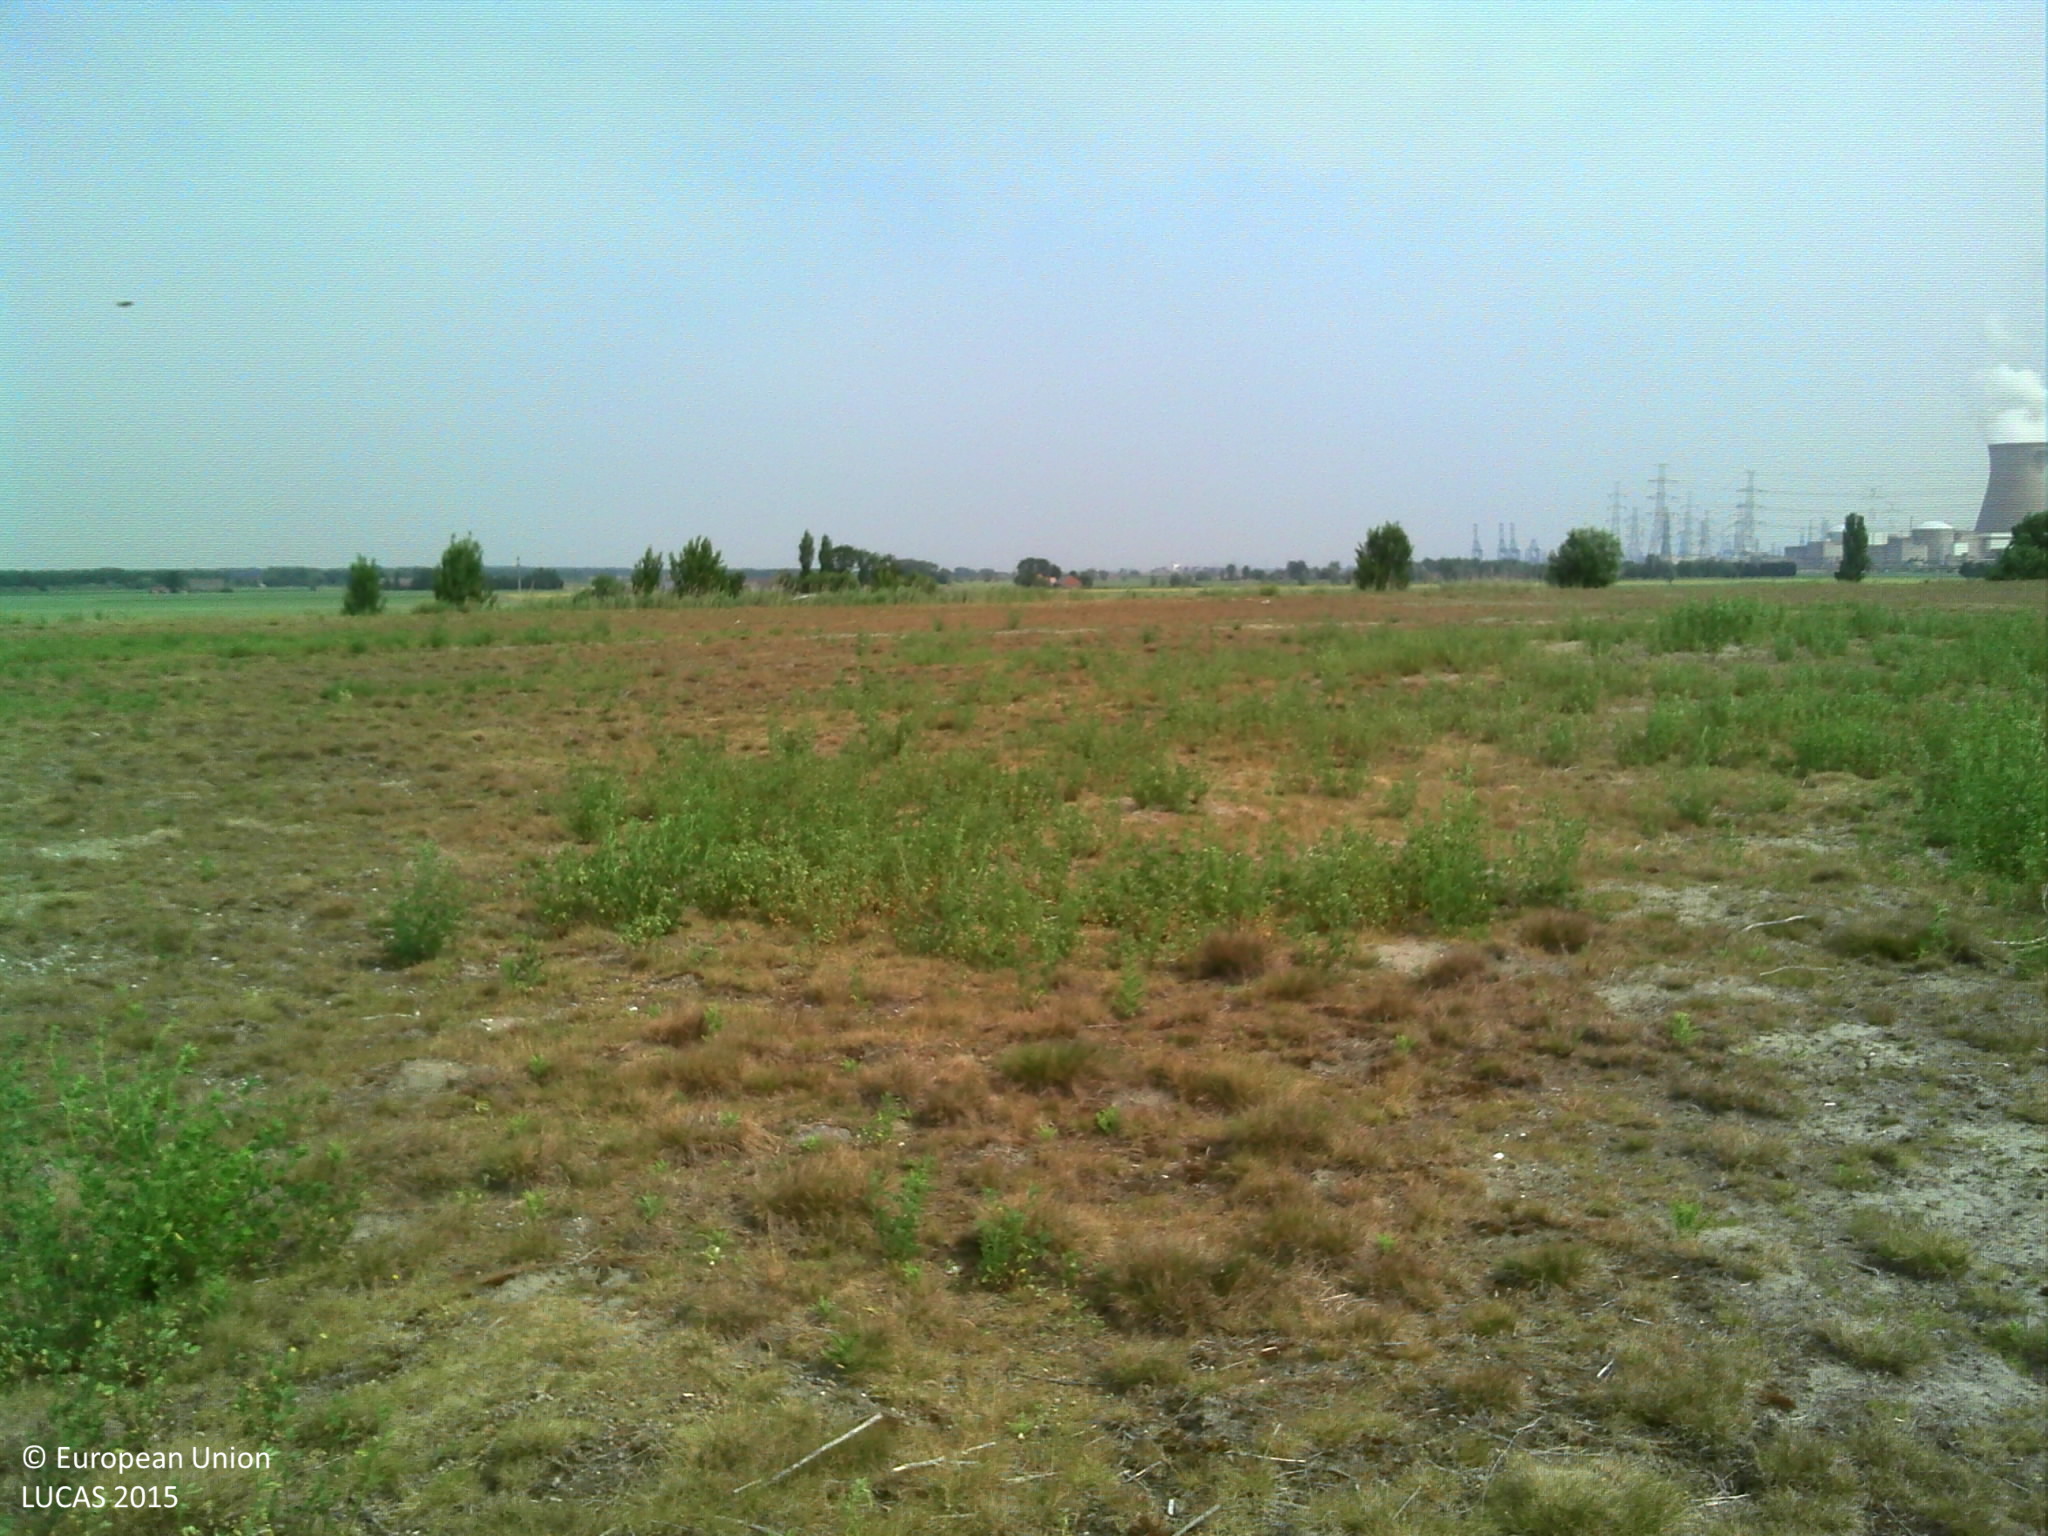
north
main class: Grassland
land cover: Spontaneously vegetated surfaces
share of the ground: > 75 %
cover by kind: herbaceous plants 100 %
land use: Semi-natural and natural areas not in use
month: June
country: BE
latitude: 51.3007
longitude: 4.2435
